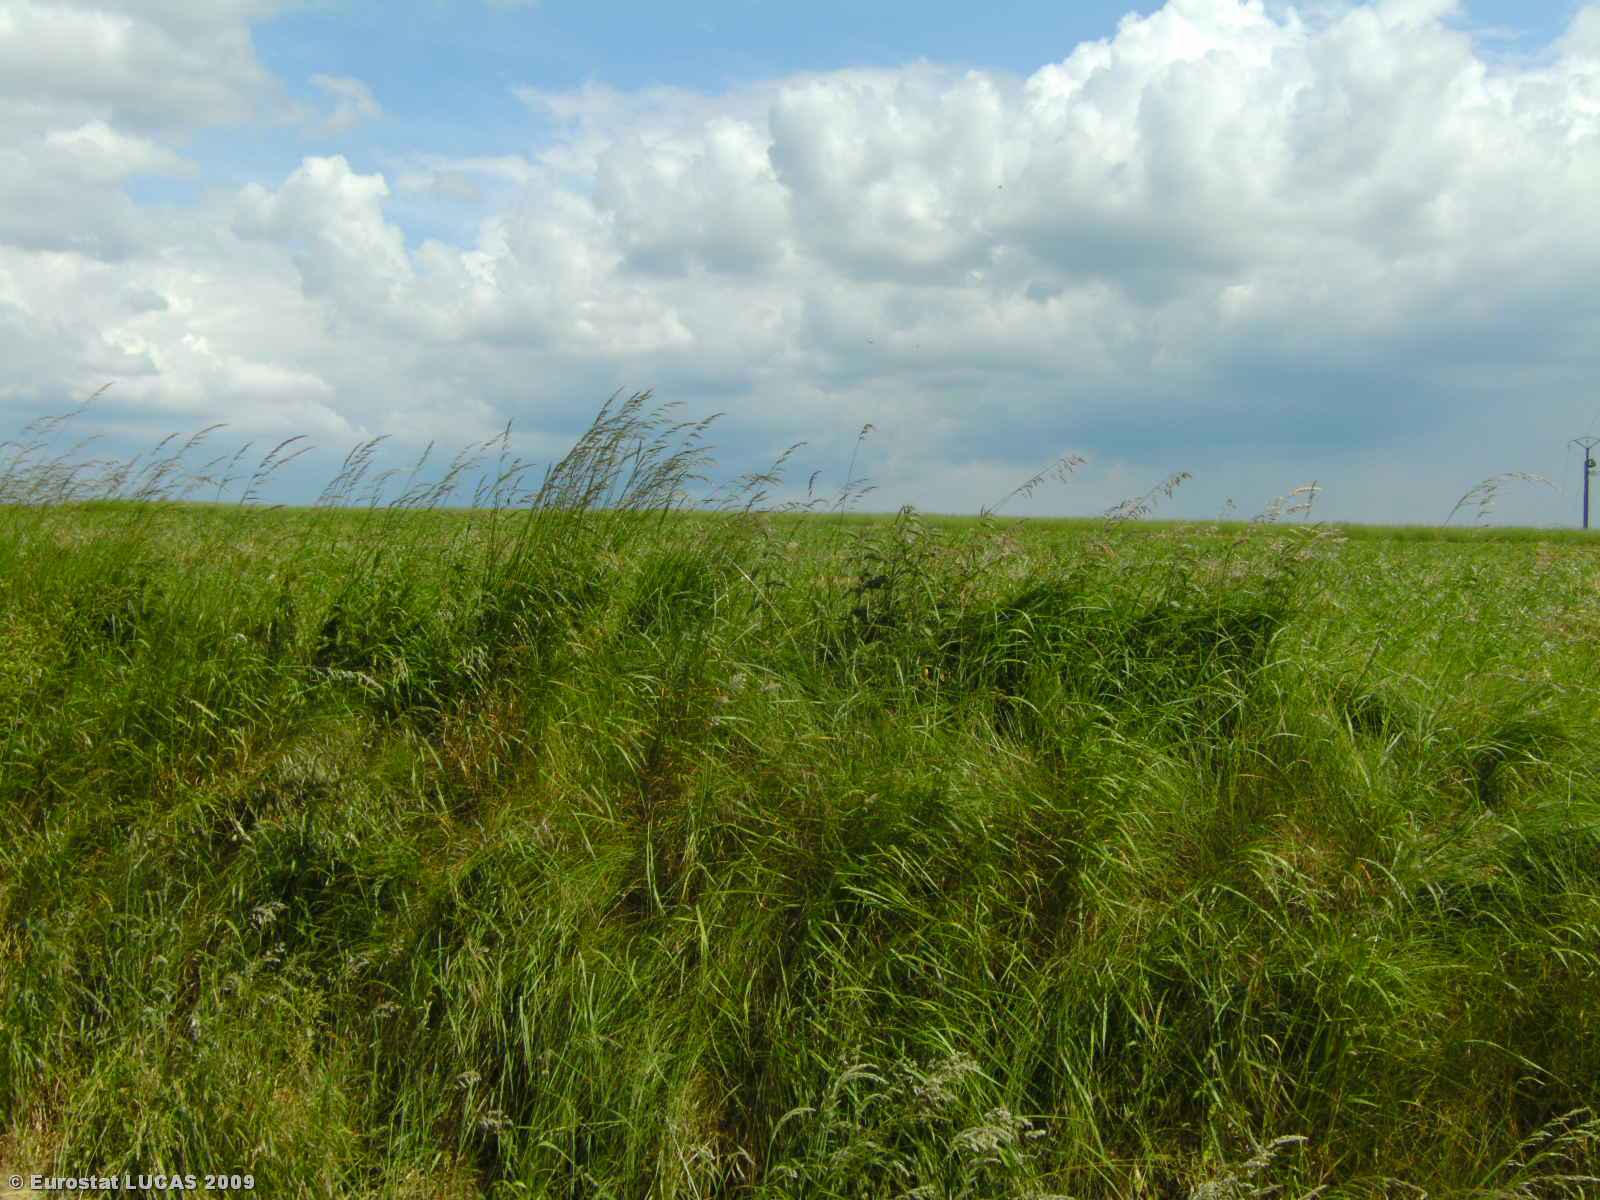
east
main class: Grassland
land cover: Grassland without tree/shrub cover
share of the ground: > 75 %
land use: Agriculture (excluding fallow land and kitchen gardens)
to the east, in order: Grassland without tree/shrub cover; Abandoned hedges; Tracks; Grassland without tree/shrub cover; Rape and turnip rape; Grassland without tree/shrub cover
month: June
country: LU
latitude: 49.5278
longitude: 6.2278
